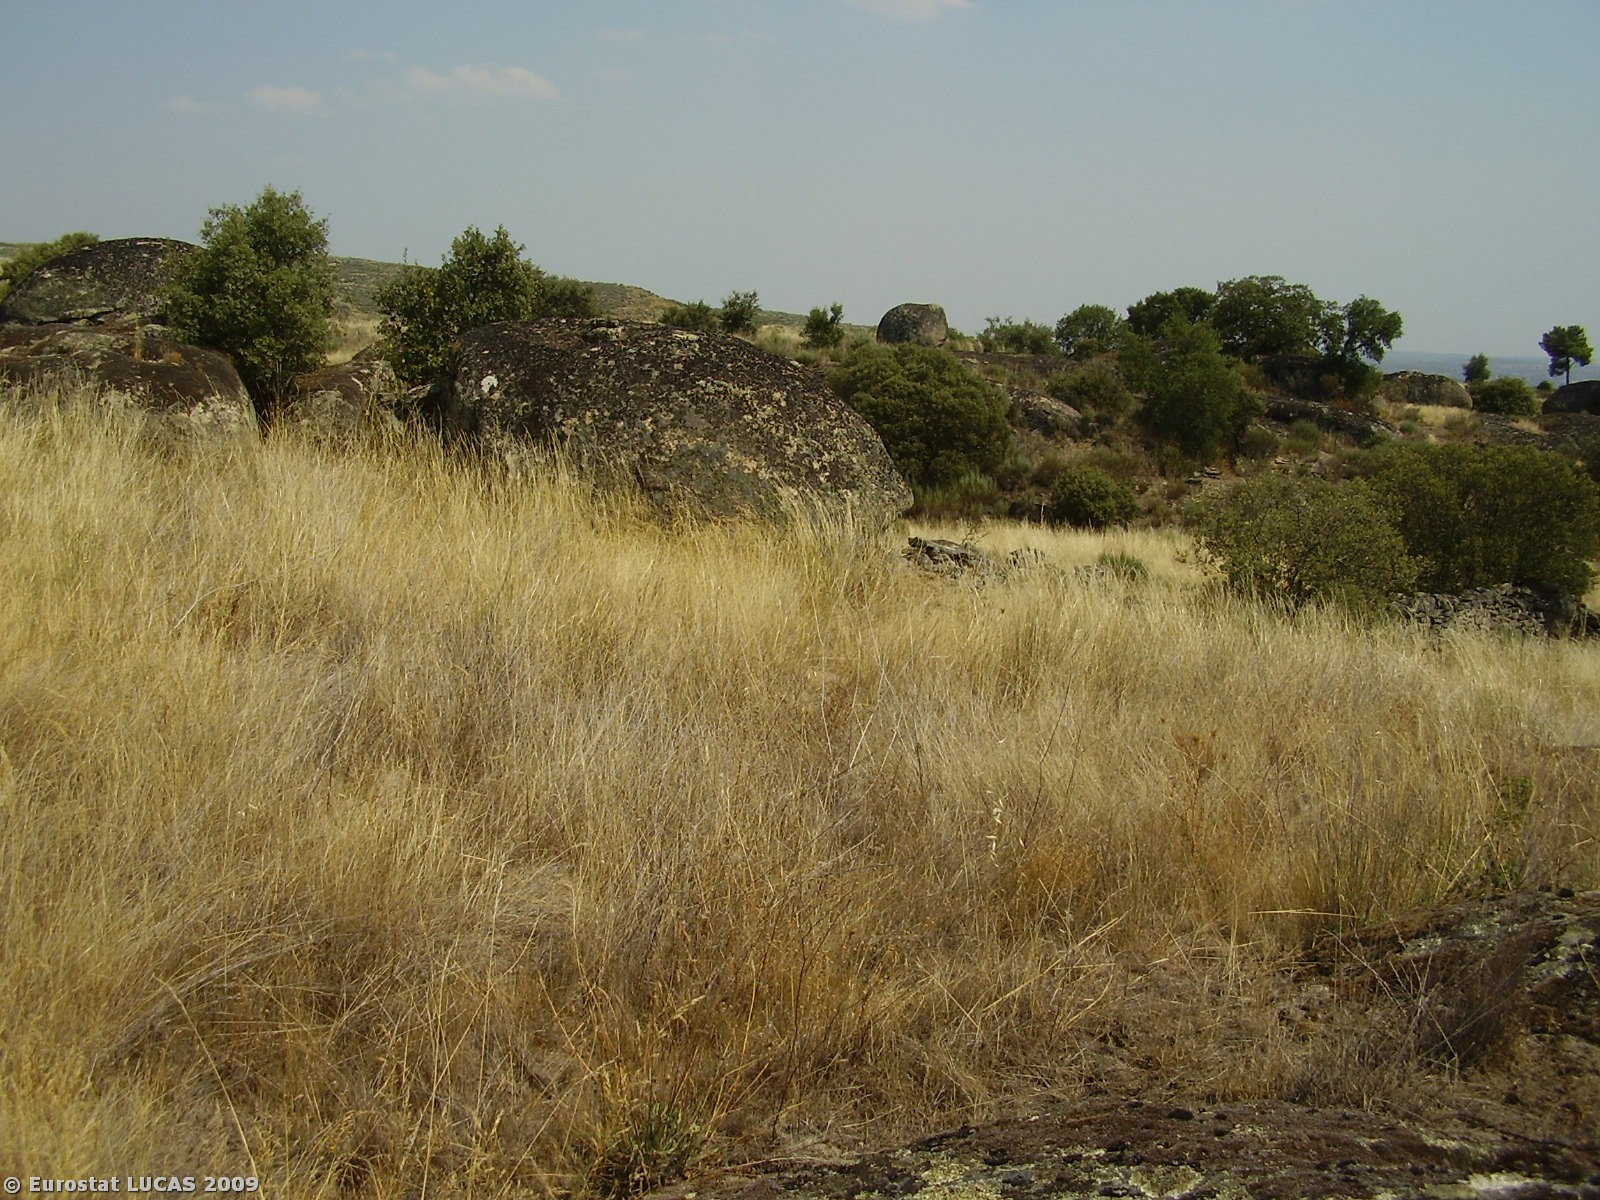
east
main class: Grassland
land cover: Grassland with sparse tree/shrub cover
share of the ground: > 75 %
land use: Fallow land
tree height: > 5 m
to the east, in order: Grassland with sparse tree/shrub cover; Rock outcrops; Shrubland without tree cover; Shrubland with sparse tree cover; Dry stone walls; Shrubland without tree cover; Rock outcrops
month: August
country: PT
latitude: 41.1689
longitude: -6.7789
